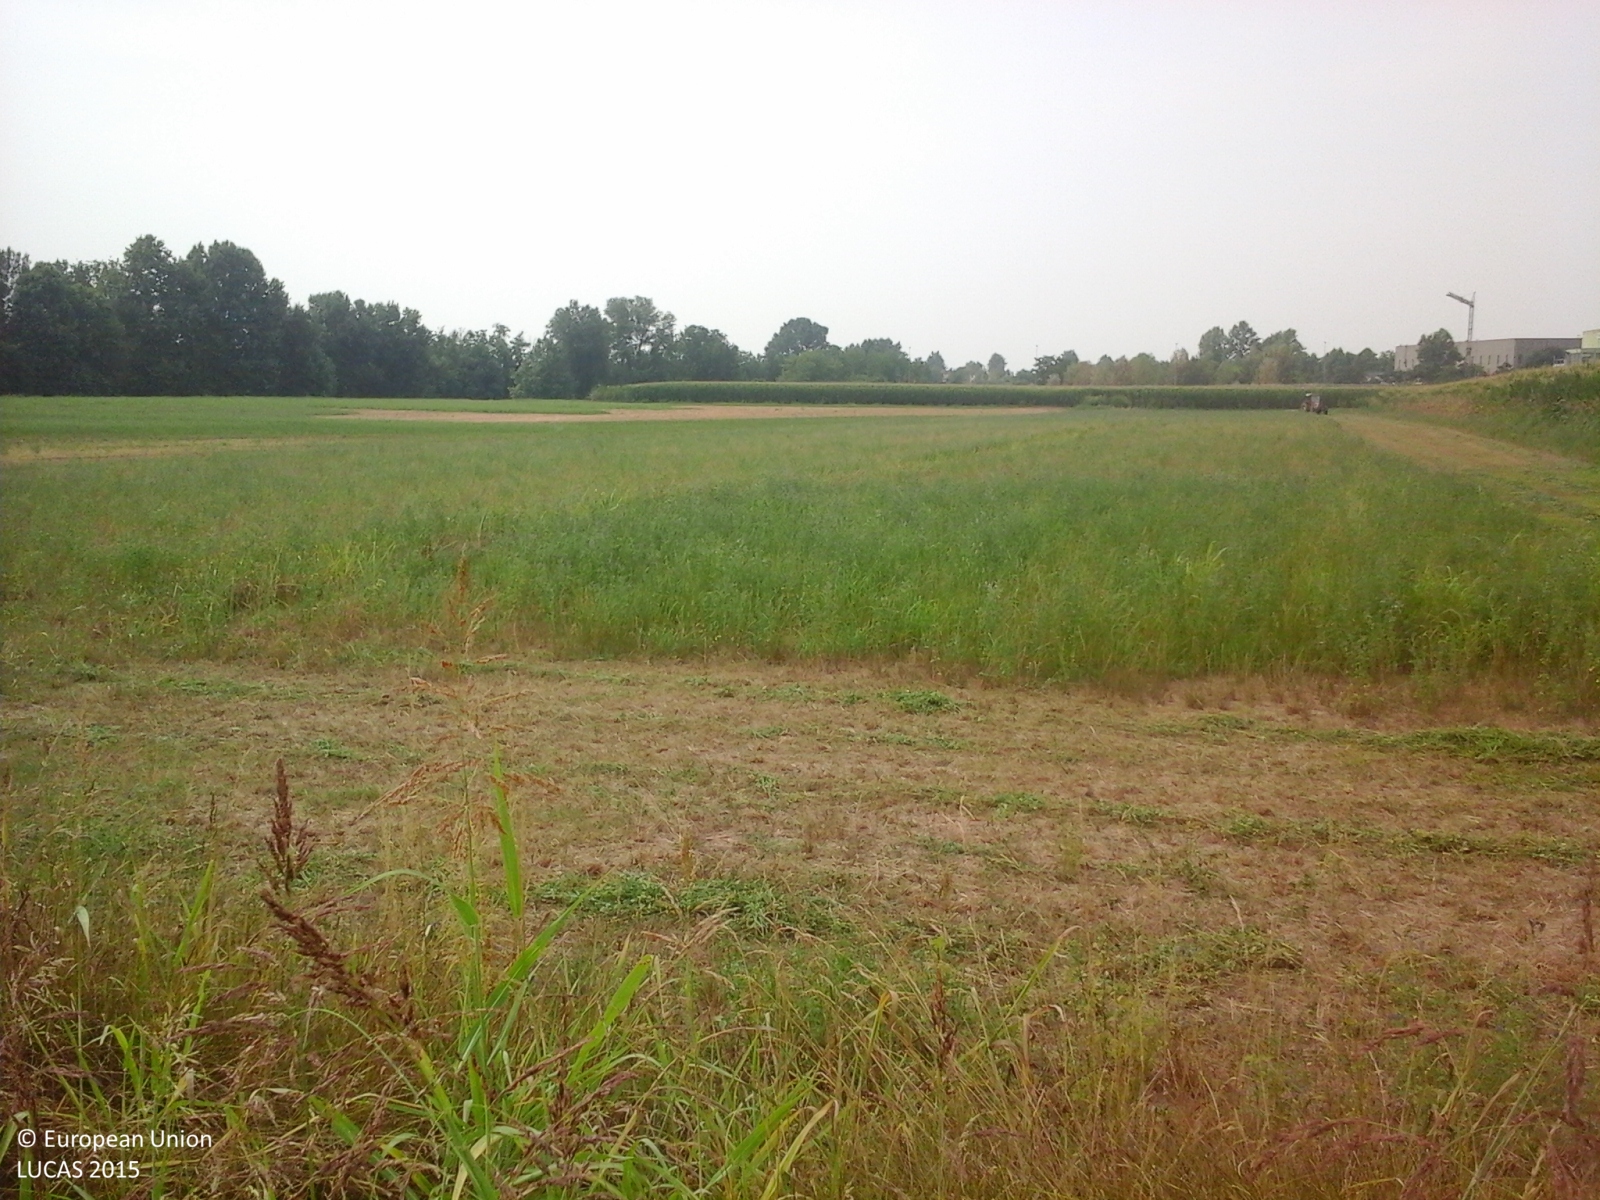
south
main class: Cropland
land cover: Lucerne
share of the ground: > 75 %
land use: Agriculture (excluding fallow land and kitchen gardens)
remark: Harvested field
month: July
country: IT
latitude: 45.4856
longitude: 10.3959
